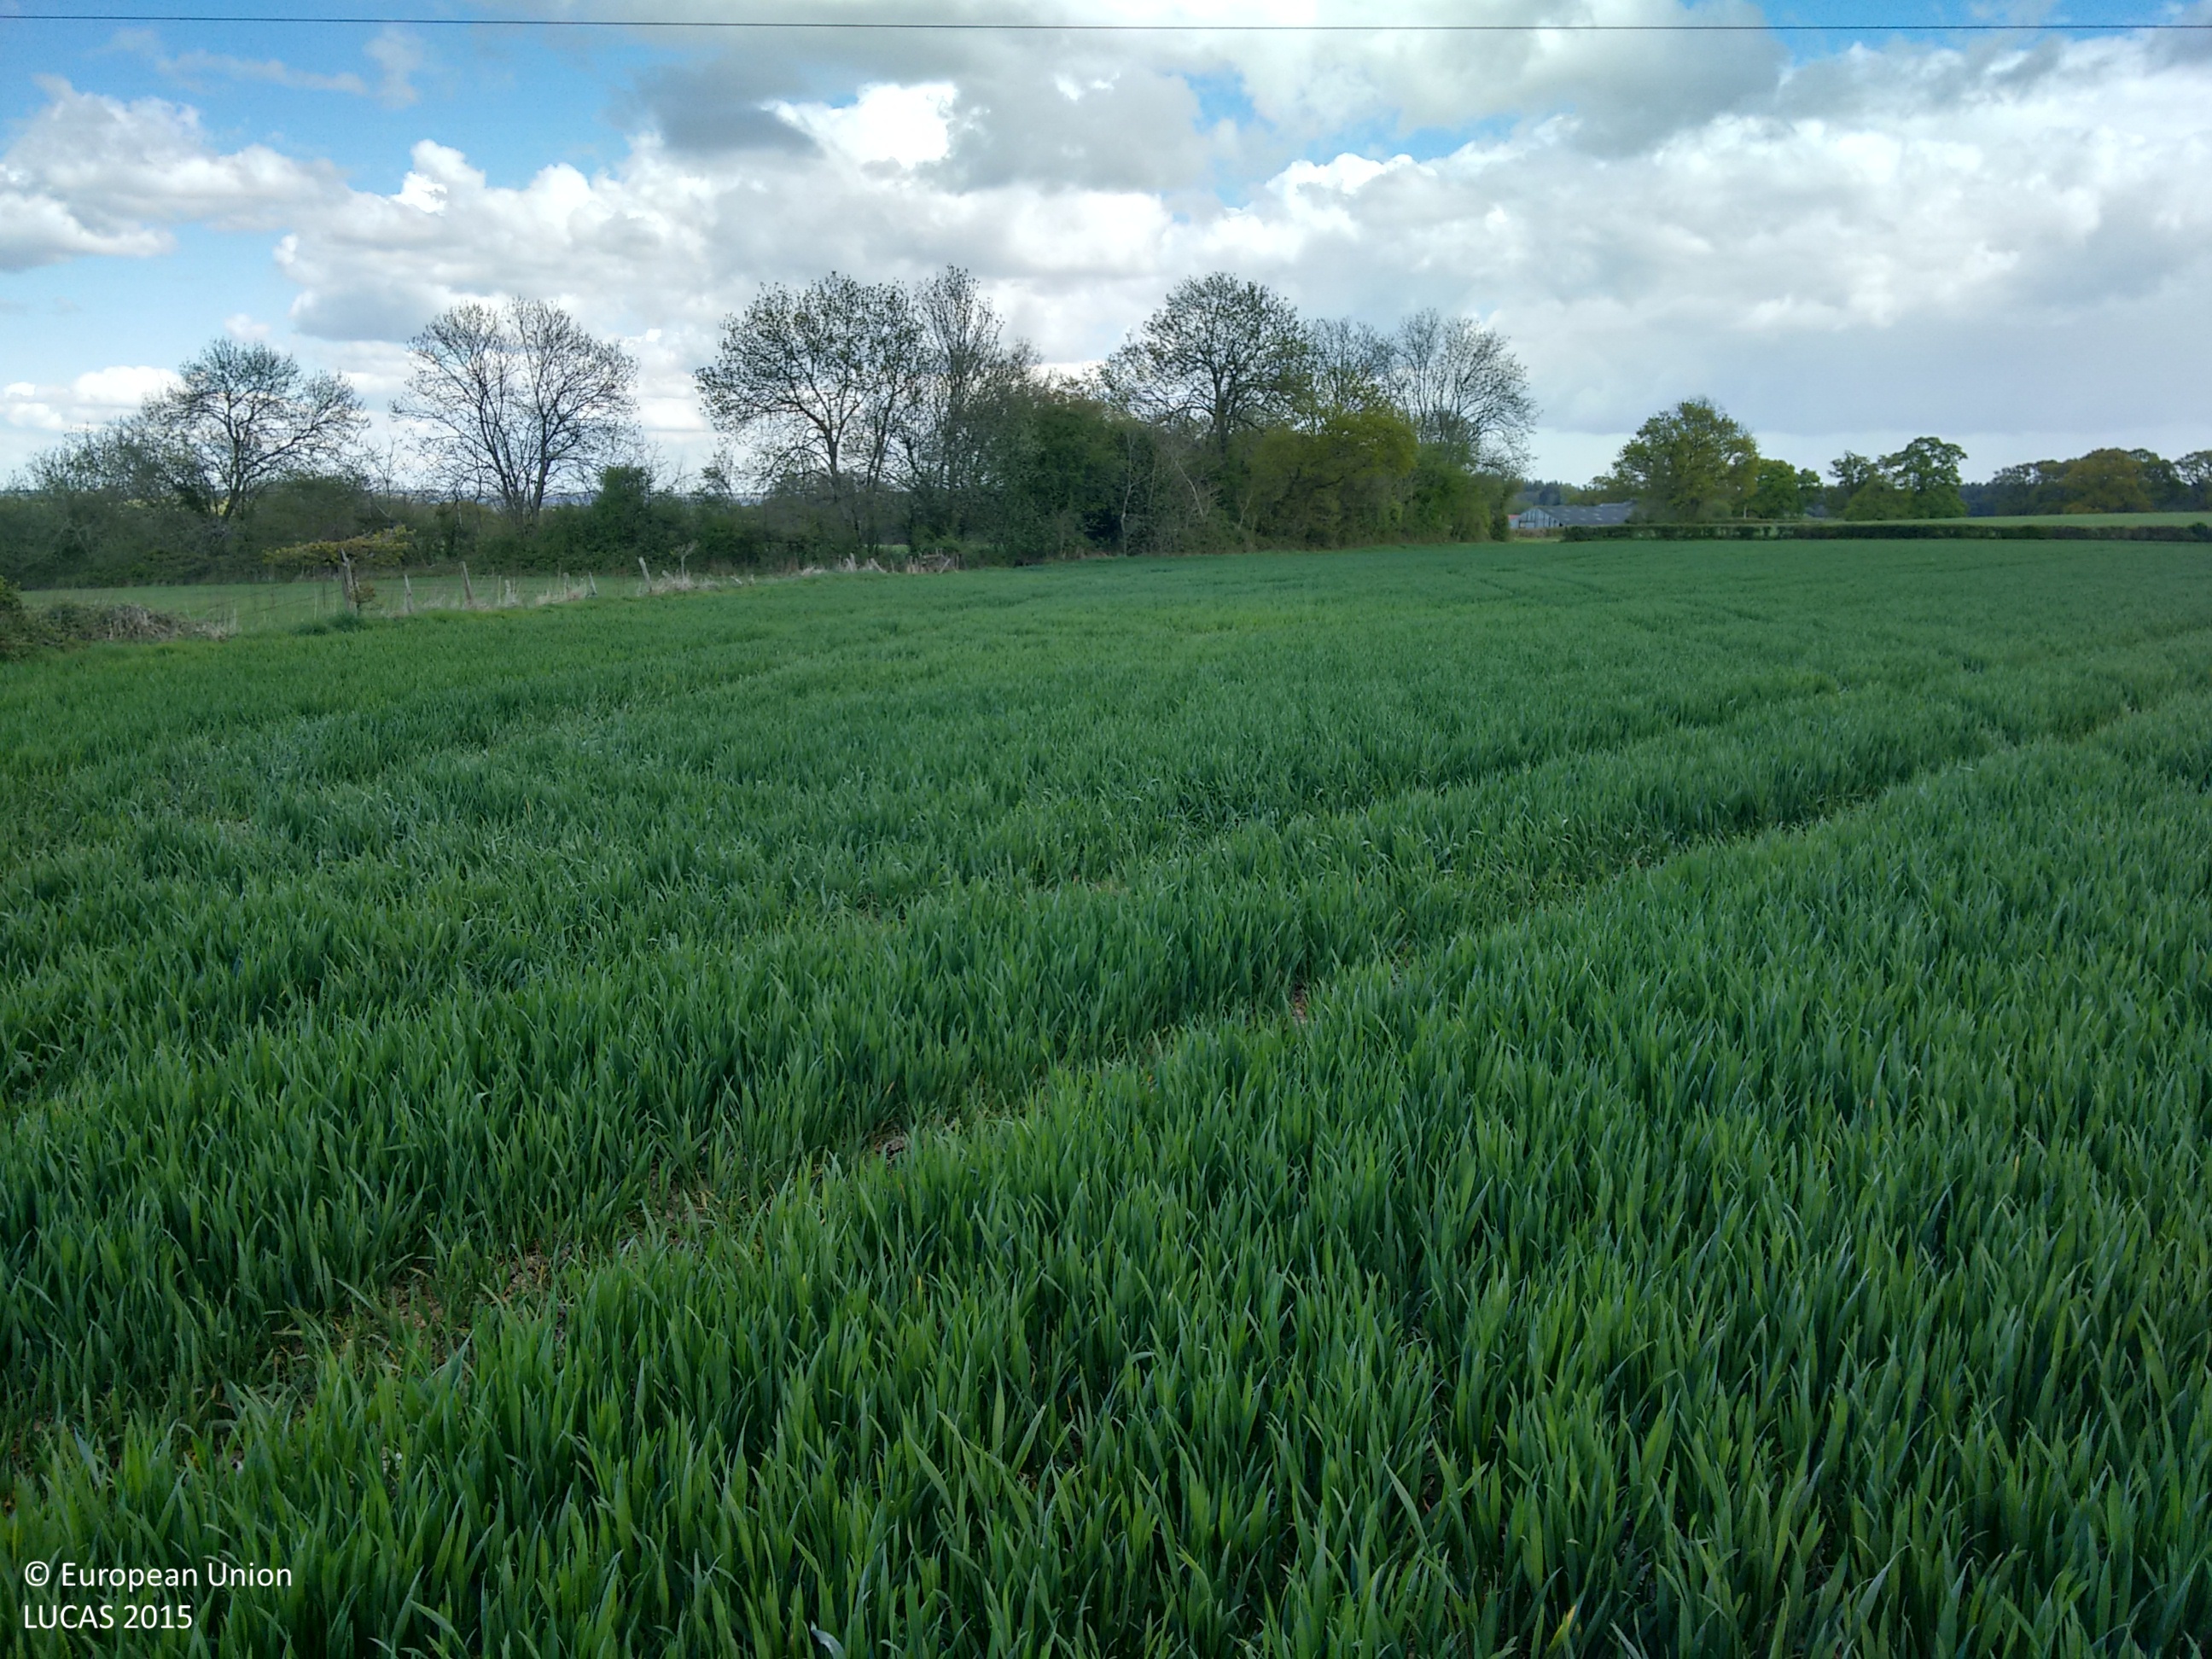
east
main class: Cropland
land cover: Common wheat
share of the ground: > 75 %
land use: Agriculture (excluding fallow land and kitchen gardens)
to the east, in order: Common wheat; Electric lines; Grass margins; Fences; Grassland without tree/shrub cover; Broadleaved woodland; Barley
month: April
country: GB
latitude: 50.9241
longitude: -1.8786
